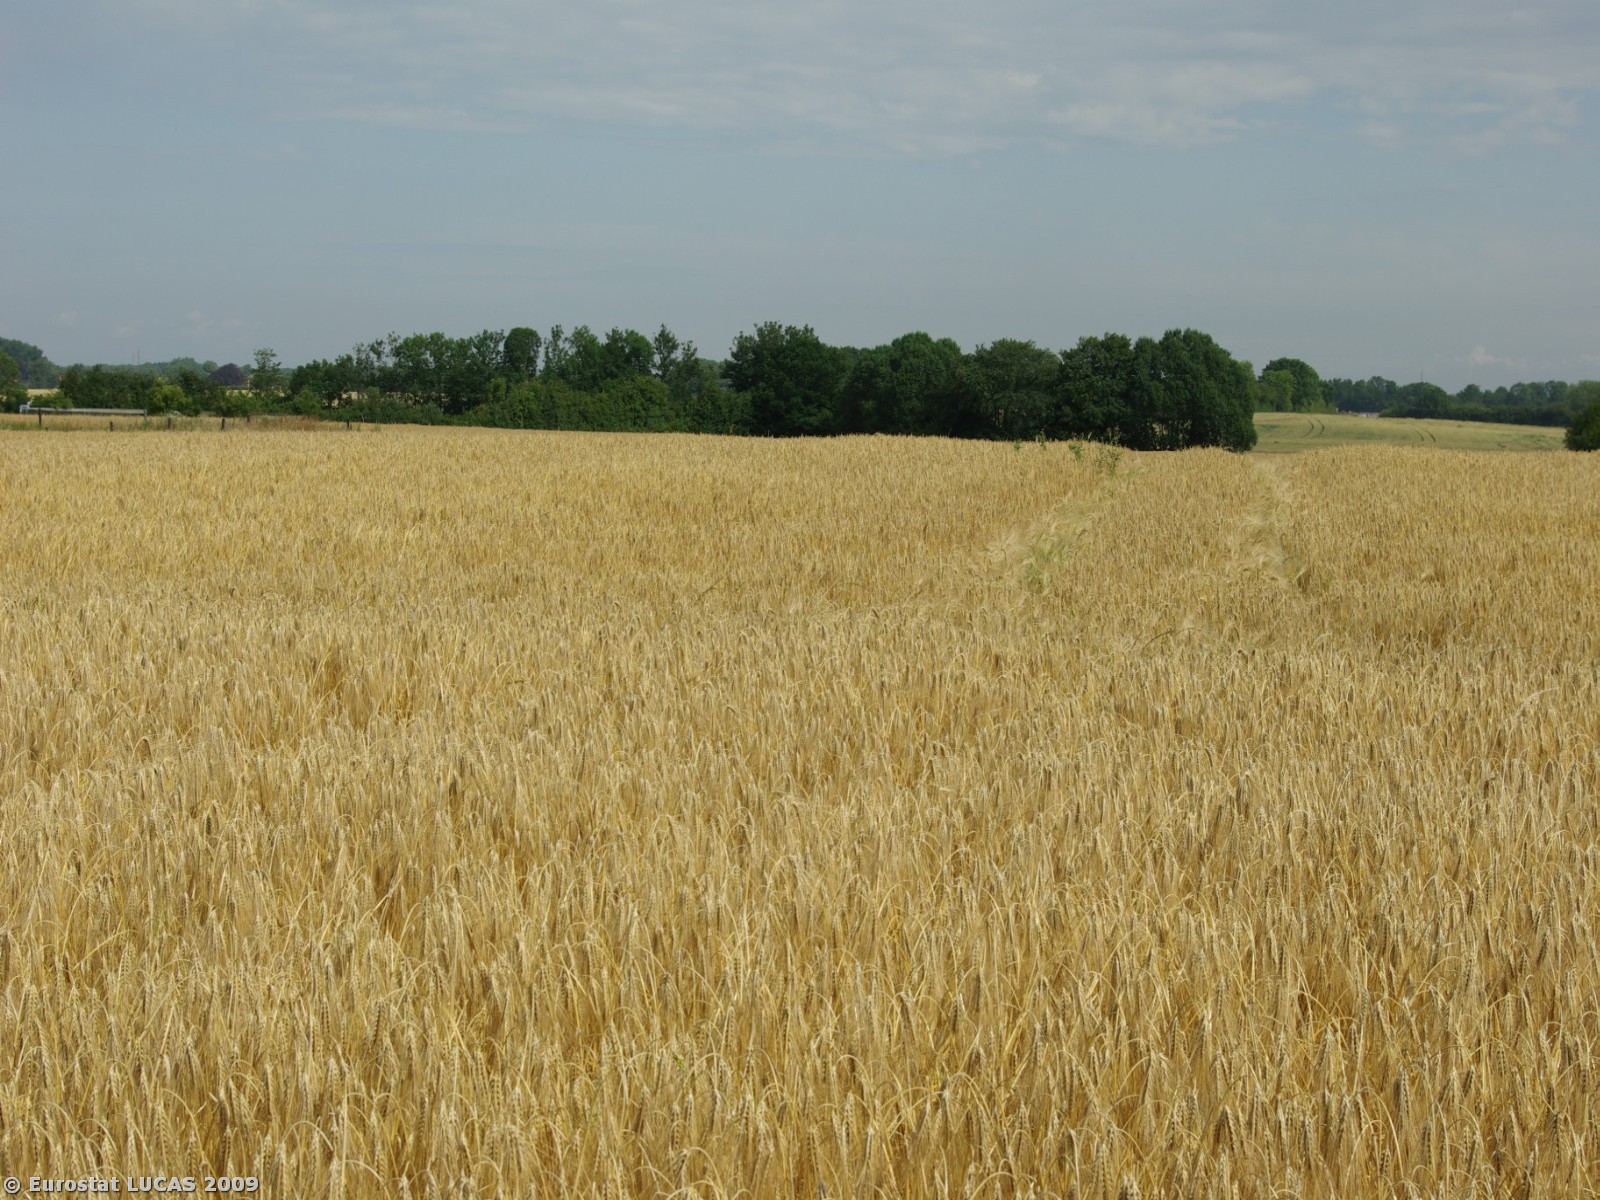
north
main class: Cropland
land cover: Barley
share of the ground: > 75 %
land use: Agriculture (excluding fallow land and kitchen gardens)
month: July
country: DK
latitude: 54.9115
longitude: 9.8597
